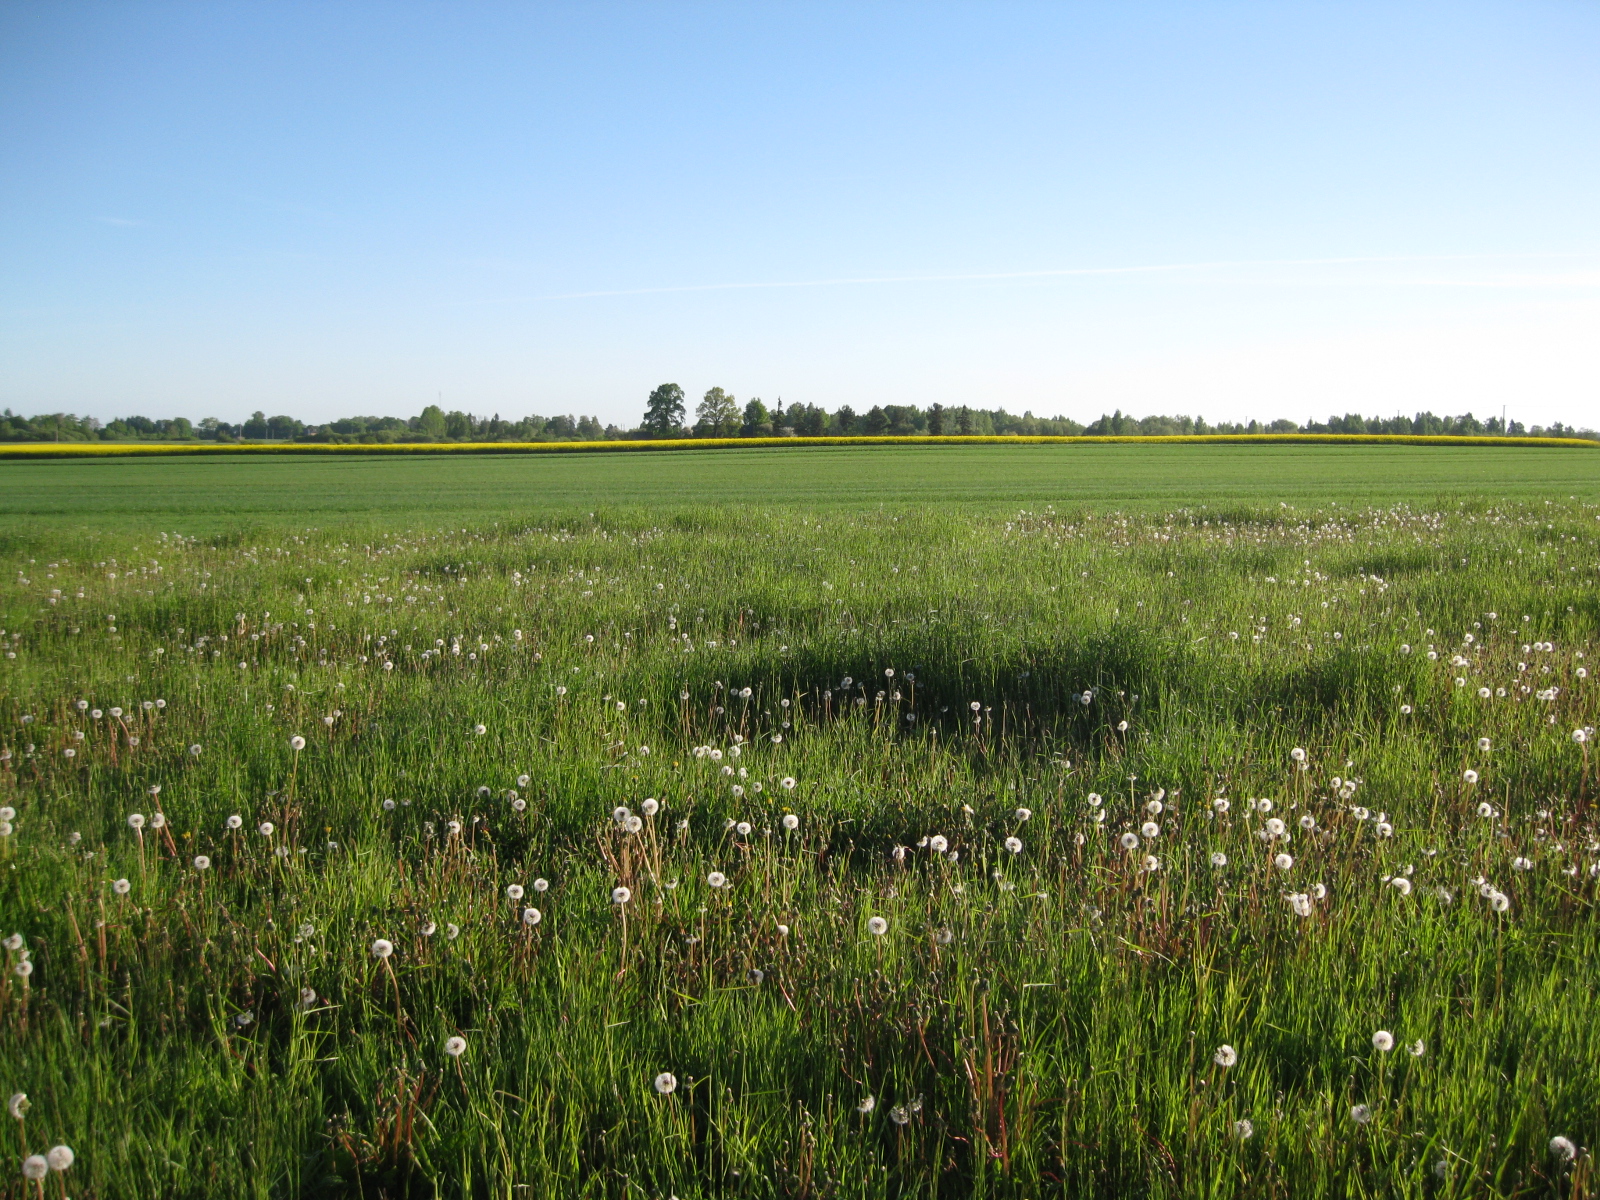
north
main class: Grassland
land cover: Grassland without tree/shrub cover
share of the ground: > 75 %
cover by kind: herbaceous plants 100 %
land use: Agriculture (excluding fallow land and kitchen gardens)
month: May
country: LT
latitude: 56.2191
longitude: 24.0033
